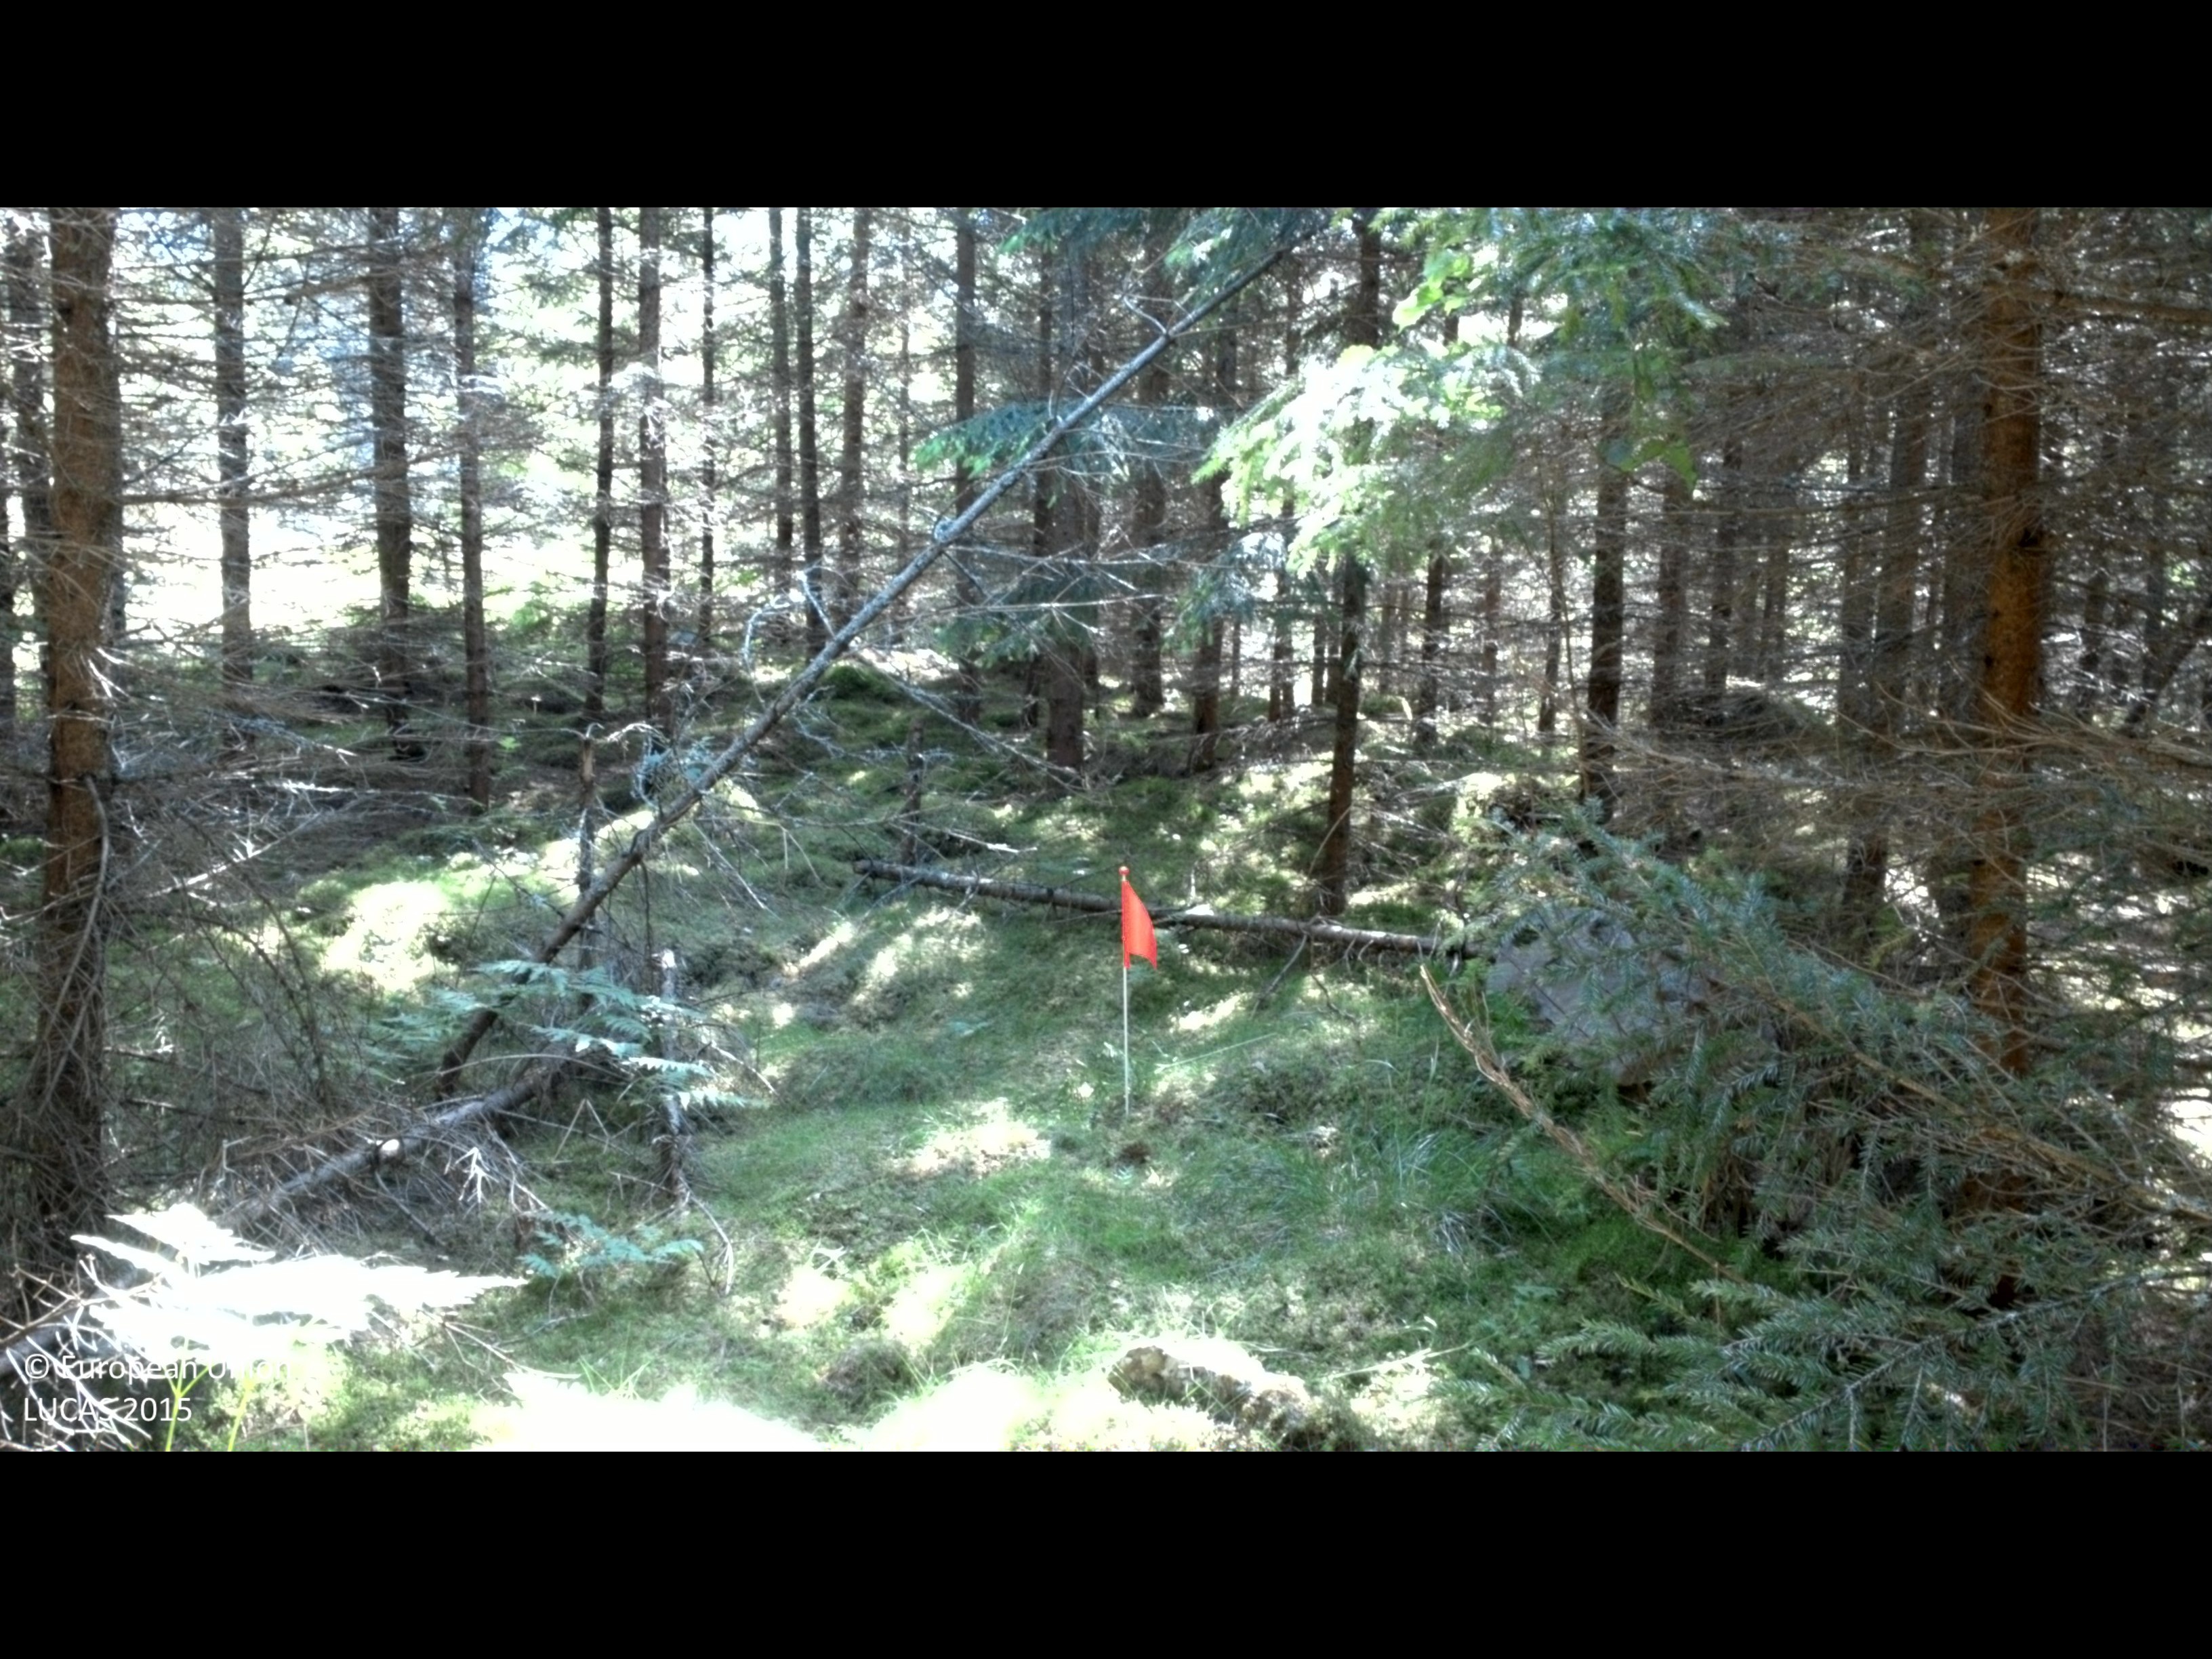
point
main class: Woodland
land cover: Spruce dominated coniferous woodland
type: boreal forest
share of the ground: > 75 %
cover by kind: coniferous forest trees 90 %, lichens and mosses 10 %
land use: Forestry
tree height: > 5 m
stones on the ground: > 50 %
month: June
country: SE
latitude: 58.1877
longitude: 16.1362
